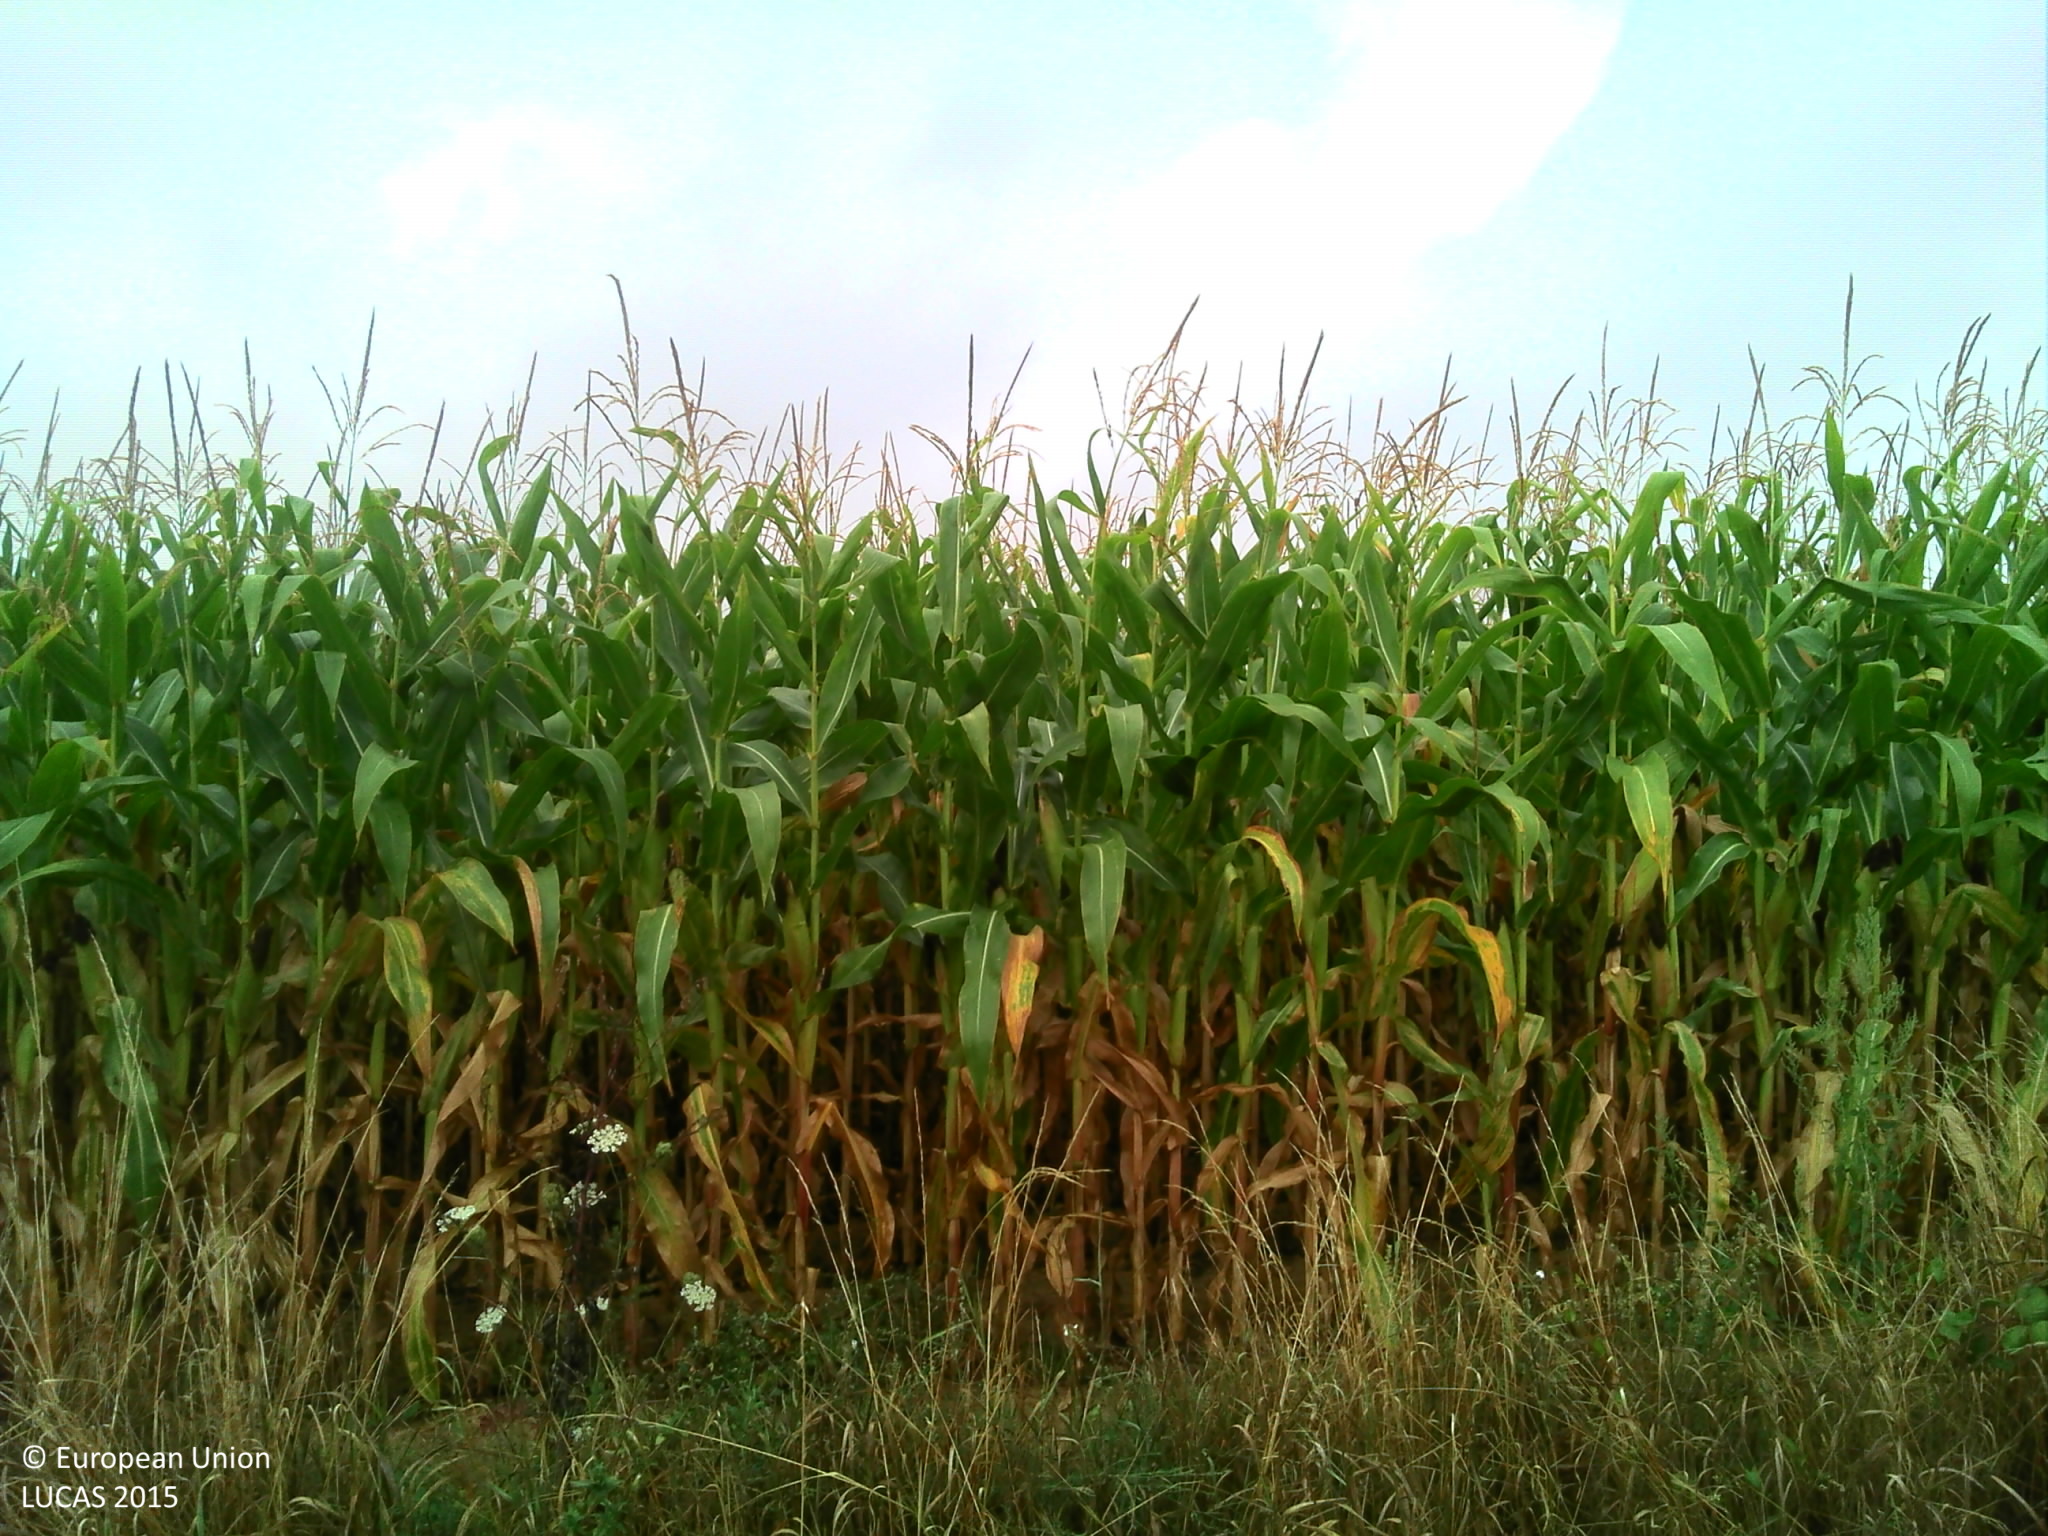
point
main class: Cropland
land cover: Maize
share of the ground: > 75 %
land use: Agriculture (excluding fallow land and kitchen gardens)
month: August
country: FR
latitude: 49.0627
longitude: 2.3921
